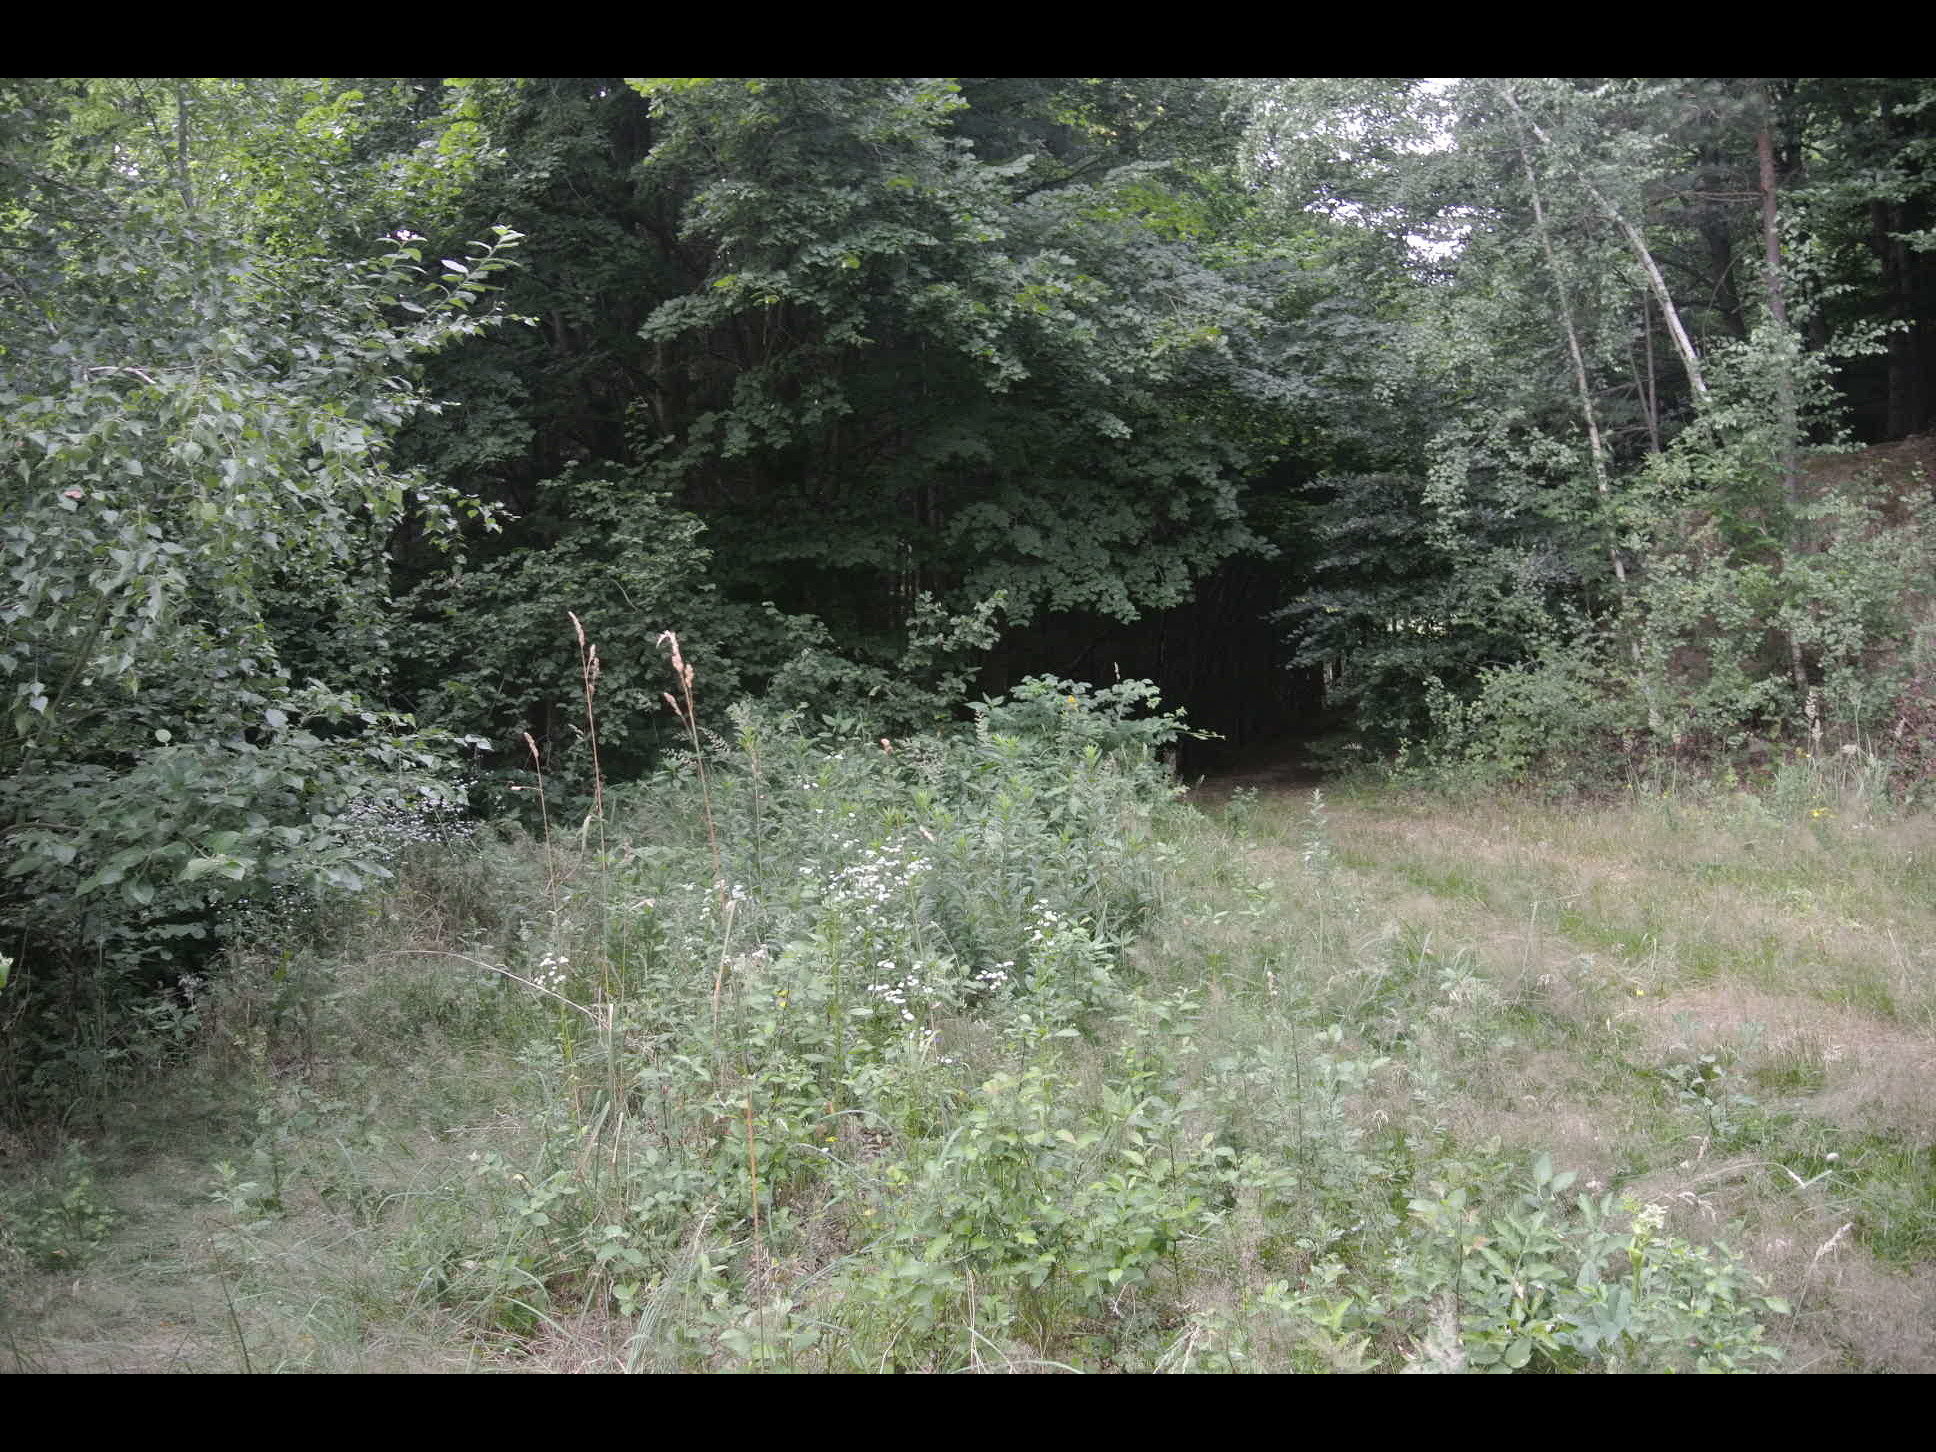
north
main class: Grassland
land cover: Grassland without tree/shrub cover
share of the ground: > 75 %
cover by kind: herbaceous plants 100 %
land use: Agriculture (excluding fallow land and kitchen gardens)
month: July
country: AT
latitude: 47.5671
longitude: 16.1038
